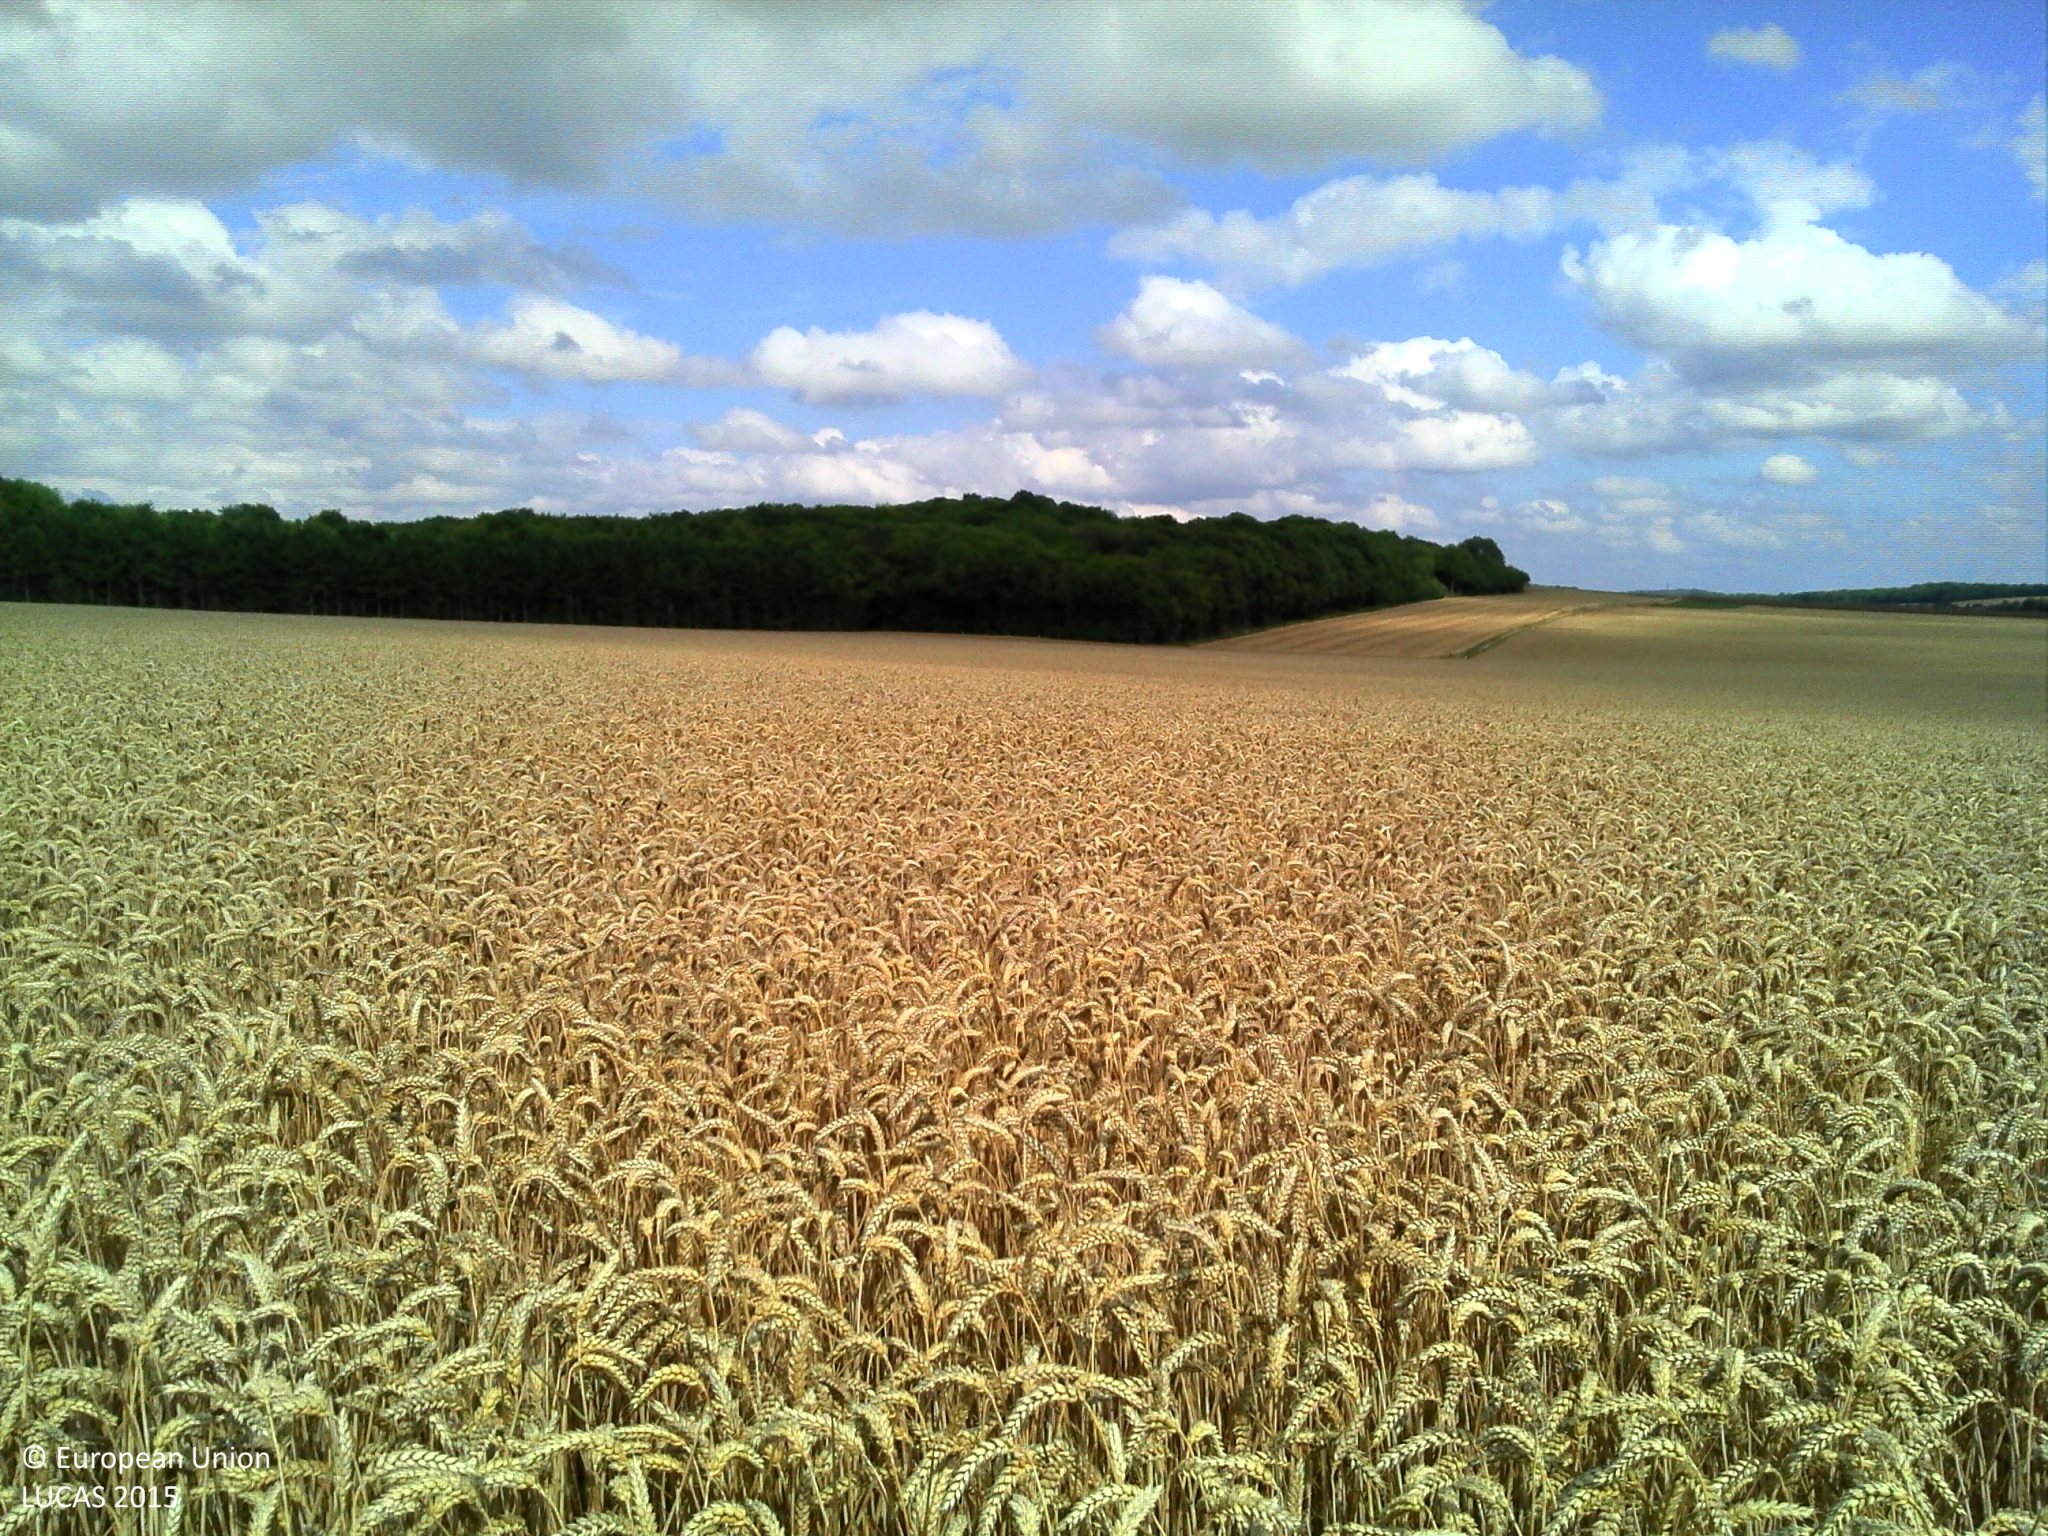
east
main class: Cropland
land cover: Common wheat
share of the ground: > 75 %
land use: Agriculture (excluding fallow land and kitchen gardens)
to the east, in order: Common wheat
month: July
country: FR
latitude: 49.9724
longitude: 2.2197
